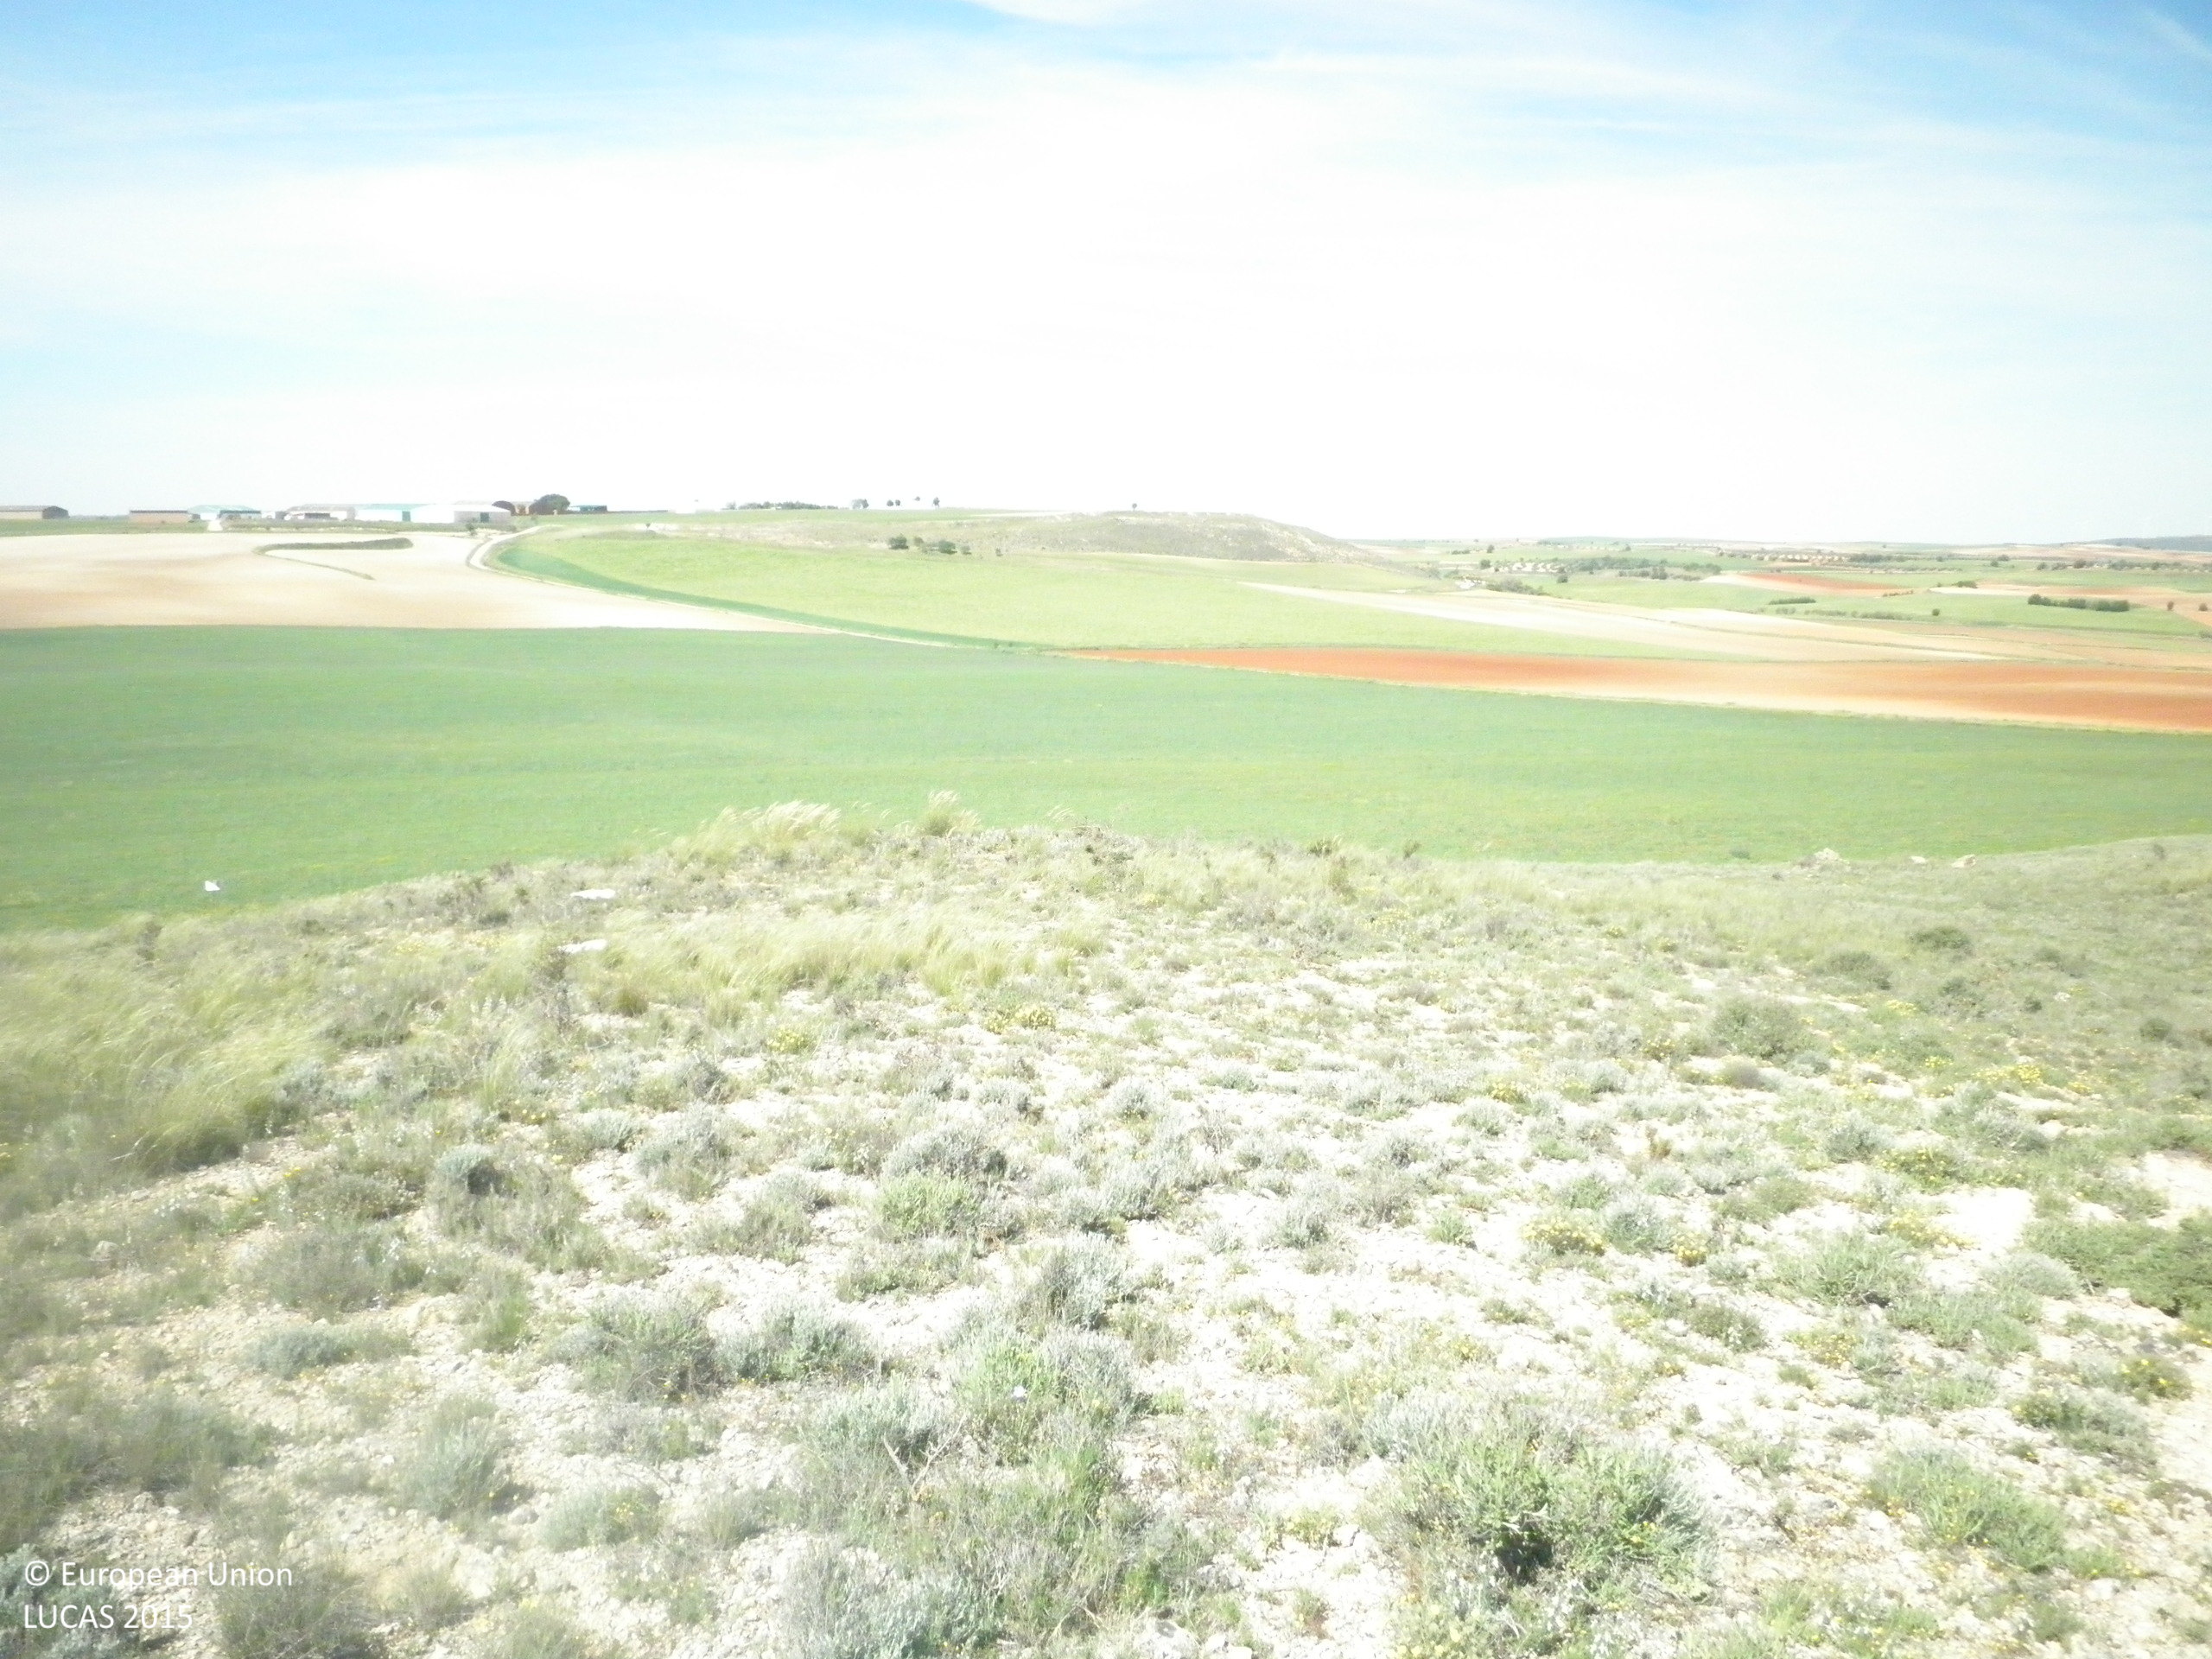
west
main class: Shrubland
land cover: Shrubland without tree cover
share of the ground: > 75 %
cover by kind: unconsolidated bare surface 50 %, herbaceous plants 25 %, shrubs 15 %, consolidated bare surface 10 %
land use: Semi-natural and natural areas not in use
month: May
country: ES
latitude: 39.7072
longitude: -2.7421
